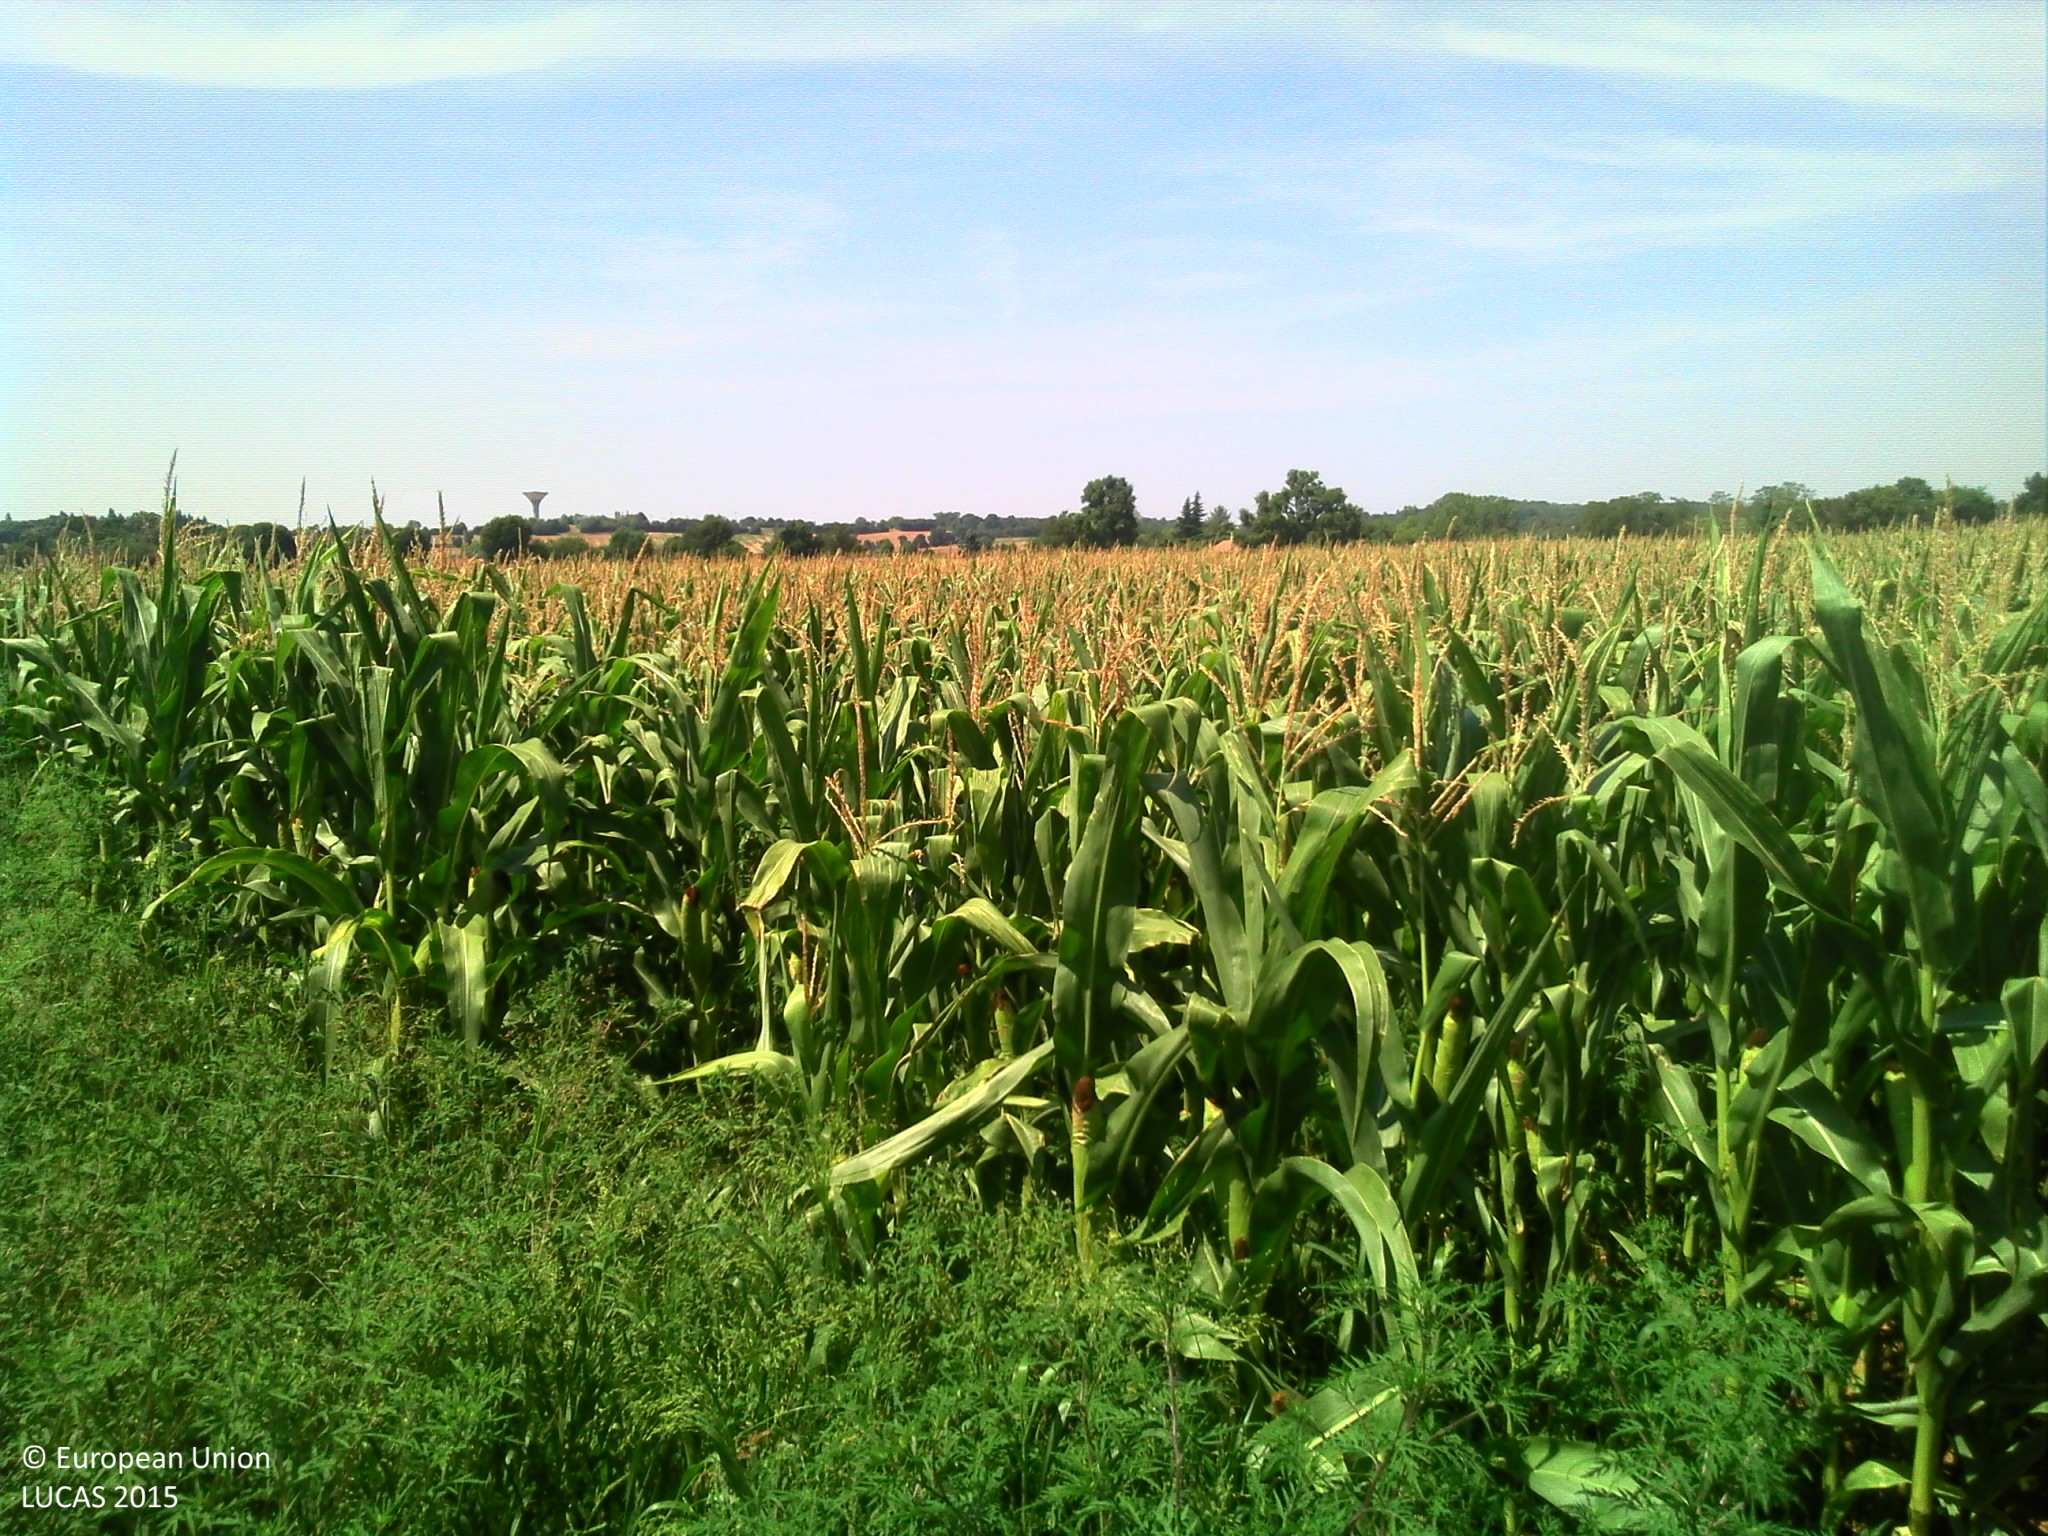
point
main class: Cropland
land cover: Maize
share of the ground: > 75 %
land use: Agriculture (excluding fallow land and kitchen gardens)
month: August
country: FR
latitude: 45.7172
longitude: 5.1349
